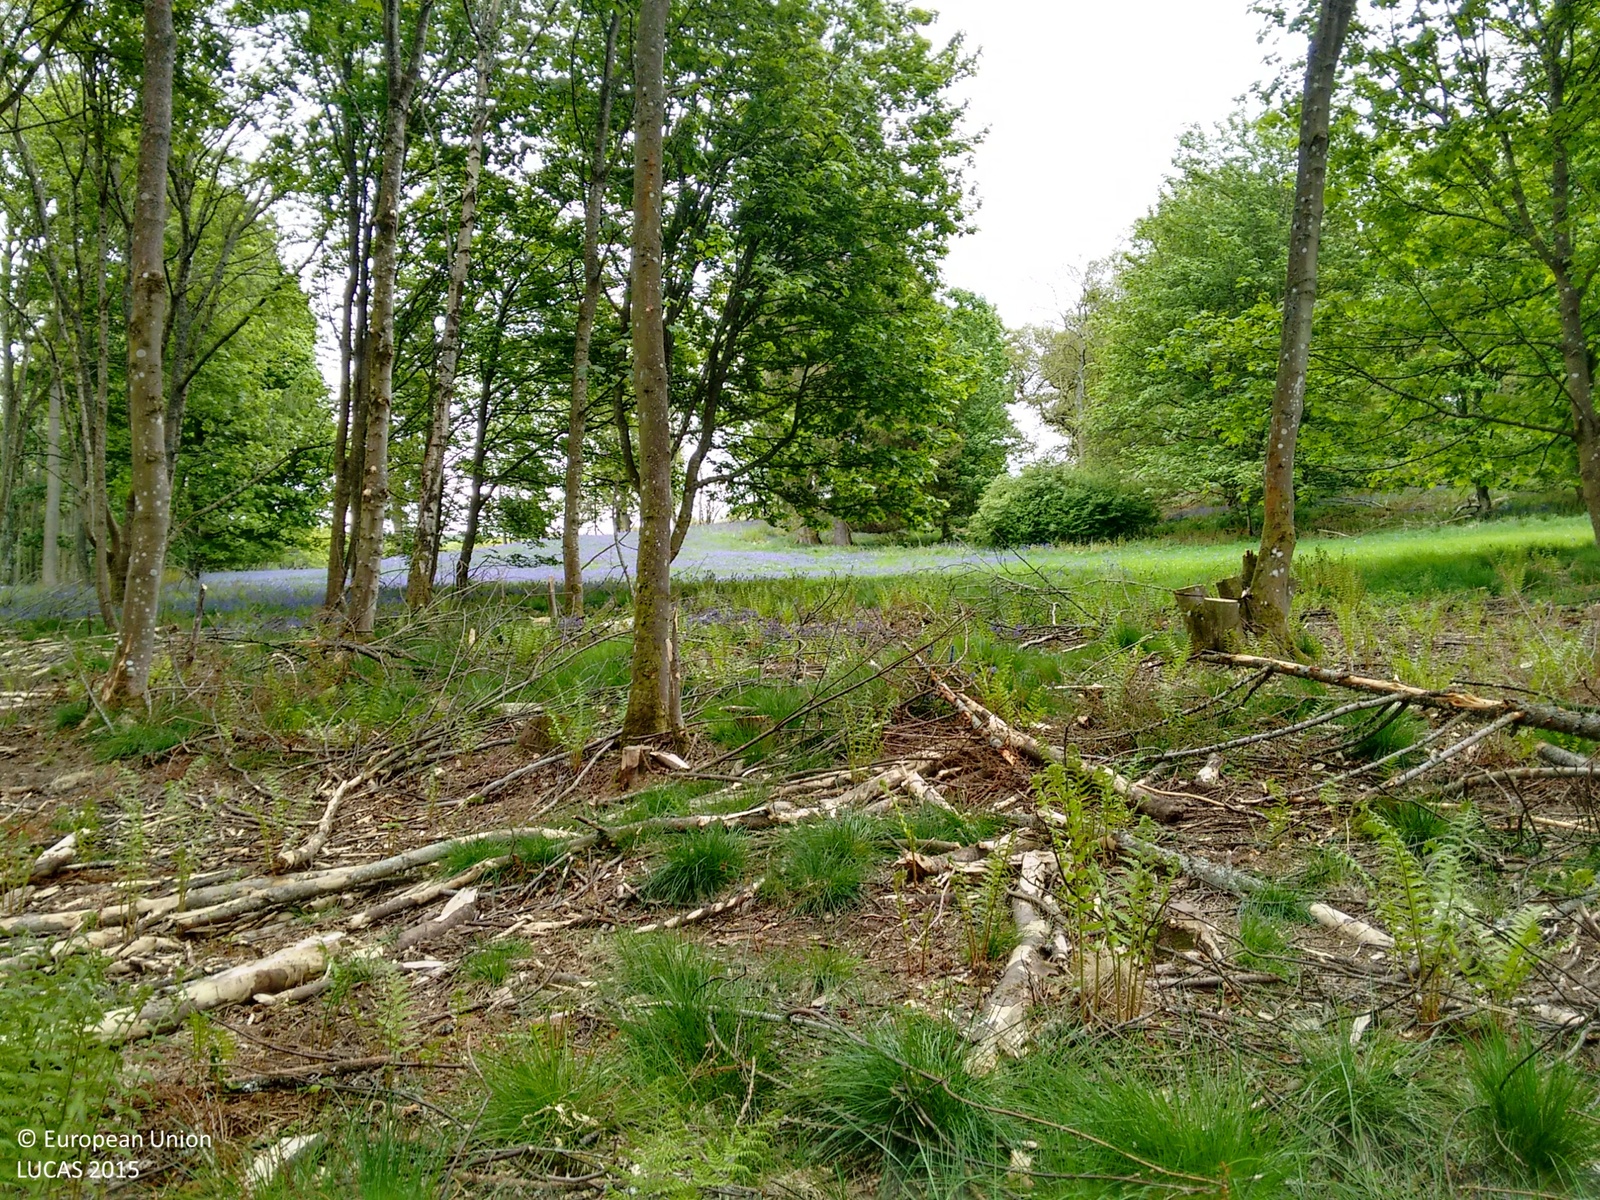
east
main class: Woodland
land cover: Other mixed woodland
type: hemiboreal forest and nemoral coniferous forest and mixed broadleaved-coniferous forest
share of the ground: > 75 %
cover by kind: broadleaved forest trees 50 %, coniferous forest trees 40 %, herbaceous plants 10 %
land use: Forestry
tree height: > 5 m
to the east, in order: Other mixed woodland; Grassland without tree/shrub cover; Broadleaved woodland; Fences; Grassland without tree/shrub cover
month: May
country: GB
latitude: 56.3267
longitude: -3.5147
